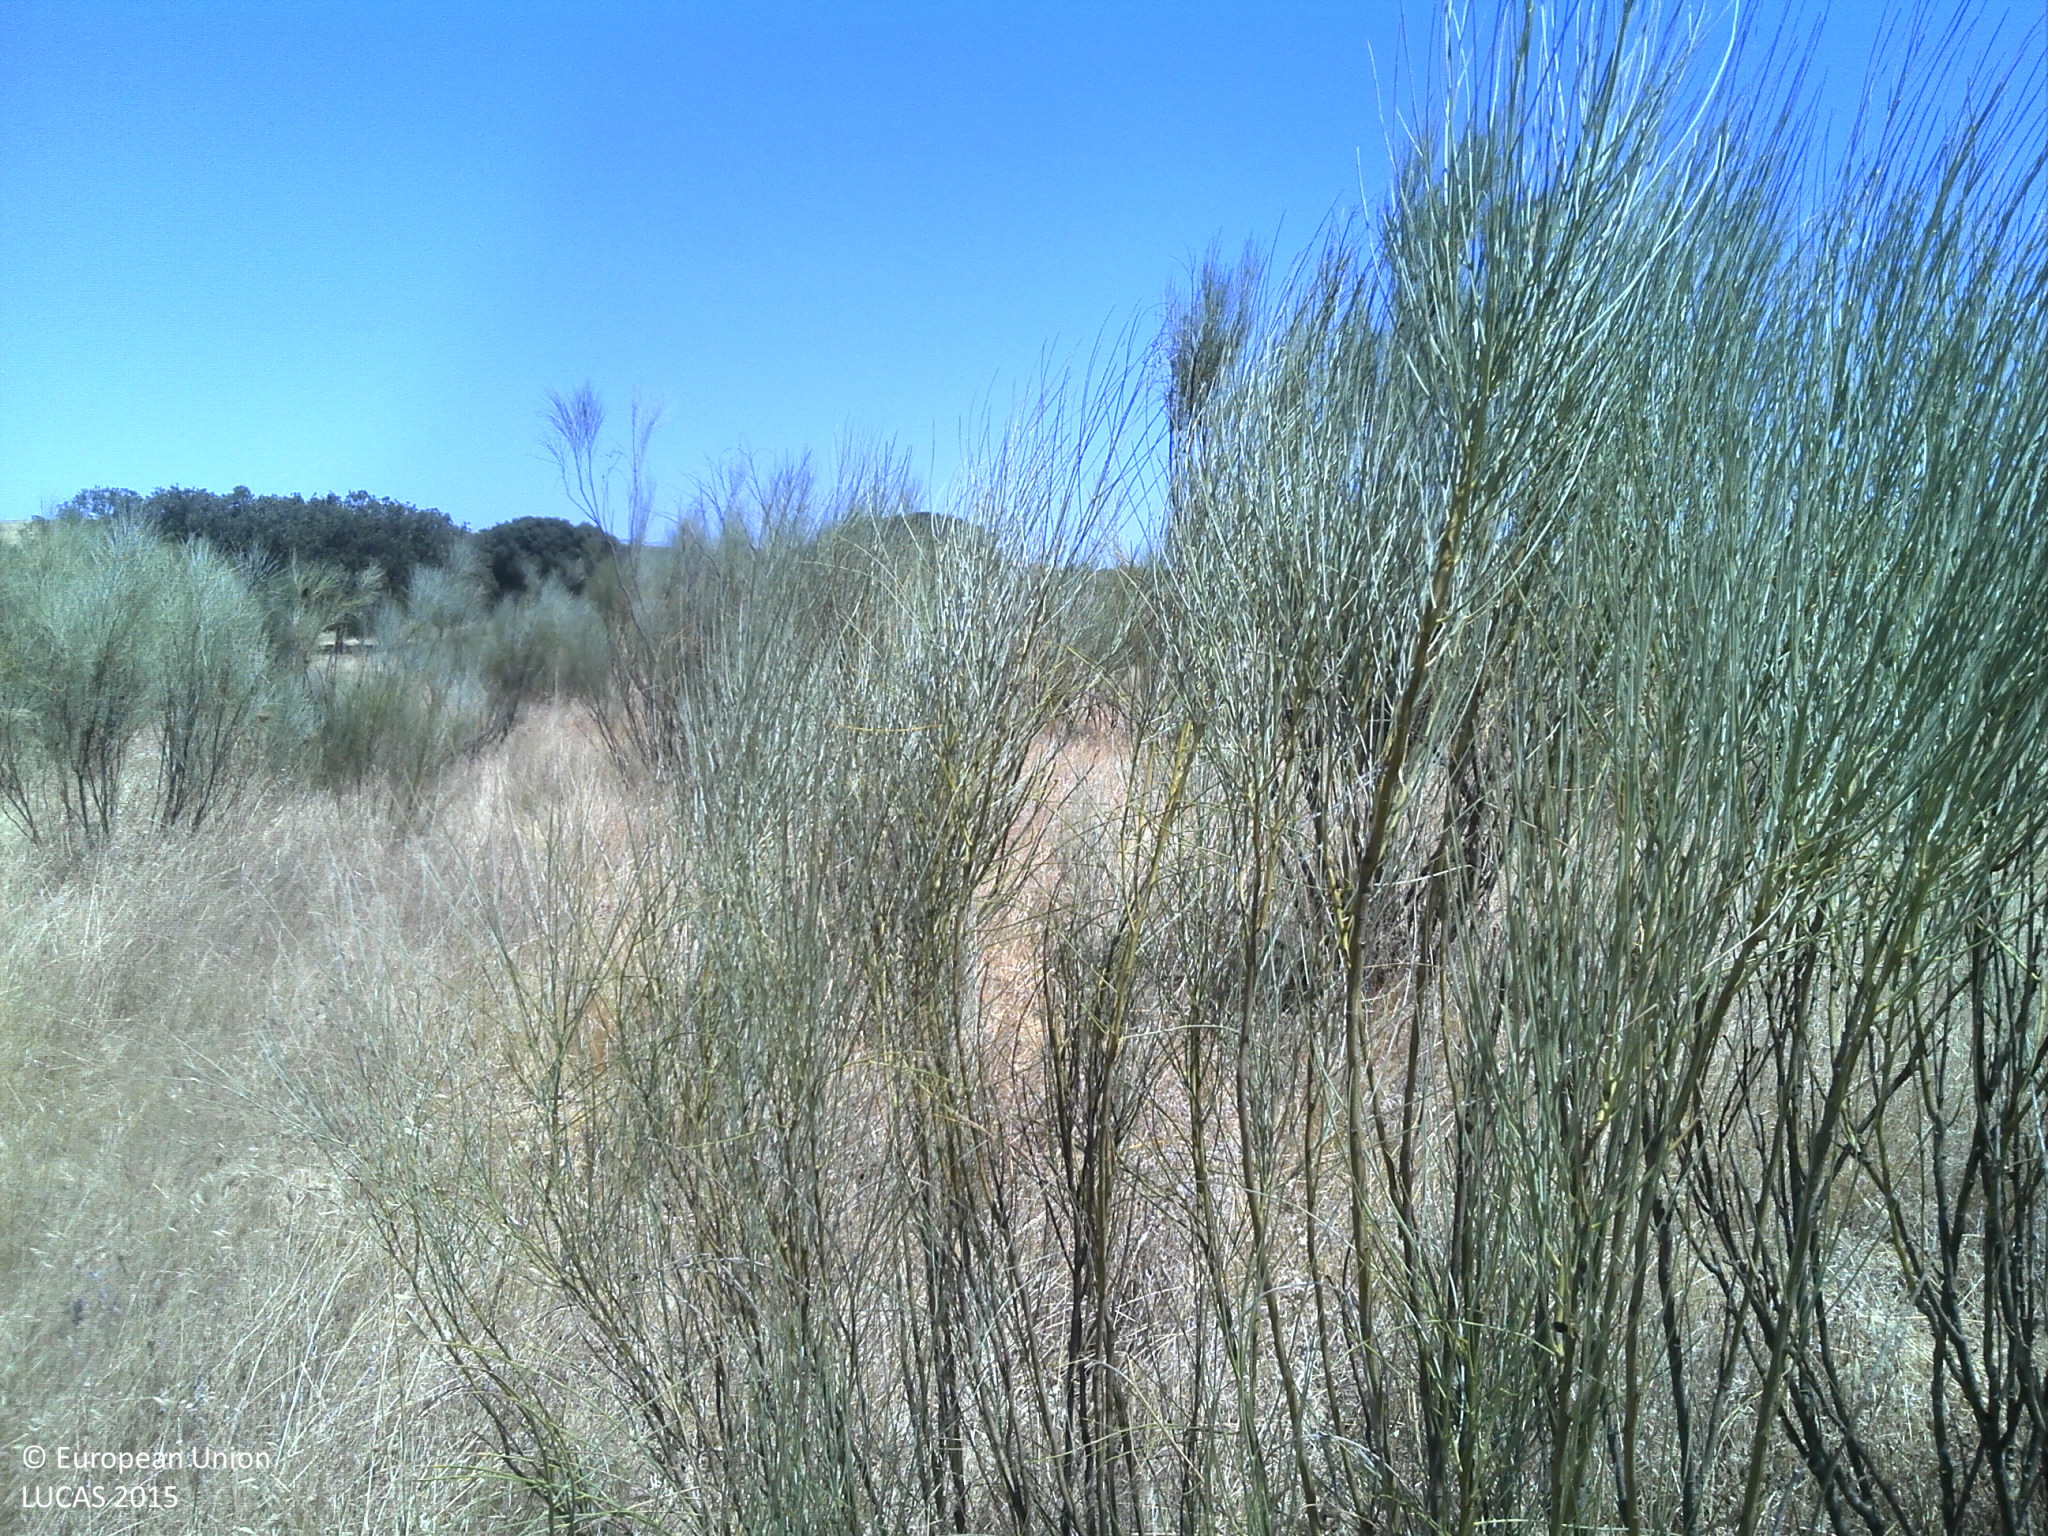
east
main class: Shrubland
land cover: Shrubland without tree cover
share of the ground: 25 - 50 %
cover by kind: herbaceous plants 50 %, shrubs 25 %, unconsolidated bare surface 25 %
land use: Agriculture (excluding fallow land and kitchen gardens)
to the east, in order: Shrubland without tree cover; Grassland with sparse tree/shrub cover; Broadleaved woodland
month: July
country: PT
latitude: 38.9884
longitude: -7.1270
